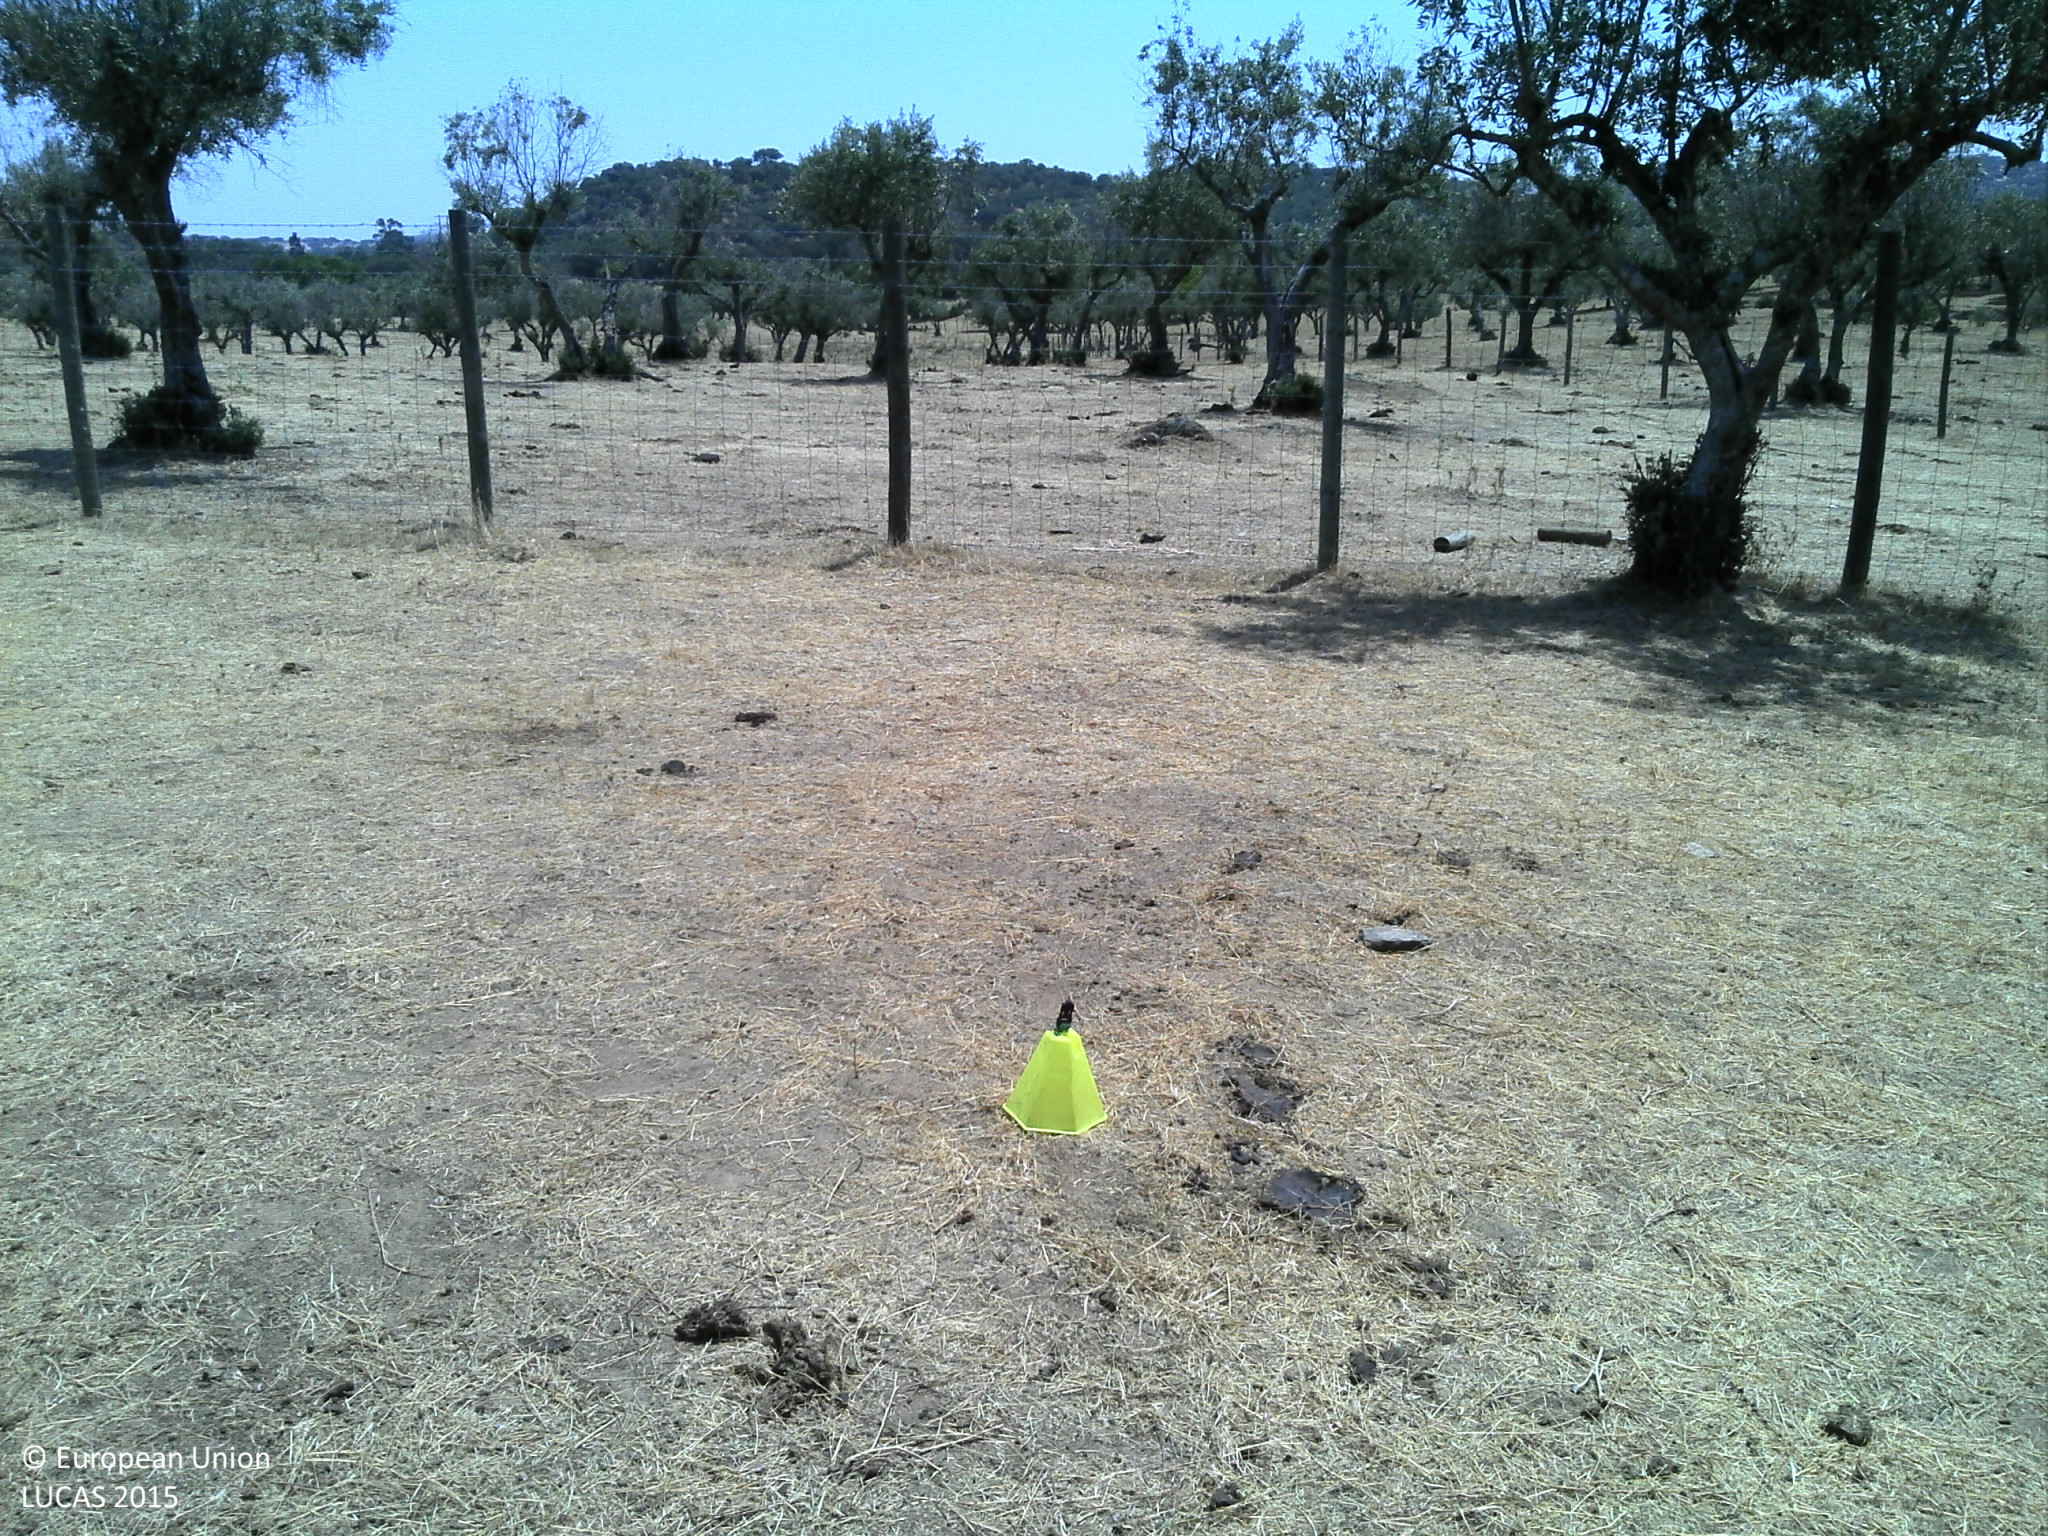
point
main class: Cropland
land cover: Olive groves
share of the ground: 25 - 50 %
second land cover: Grassland without tree/shrub cover
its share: < 10 %
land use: Agriculture (excluding fallow land and kitchen gardens)
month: July
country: PT
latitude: 38.6383
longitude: -7.5286
